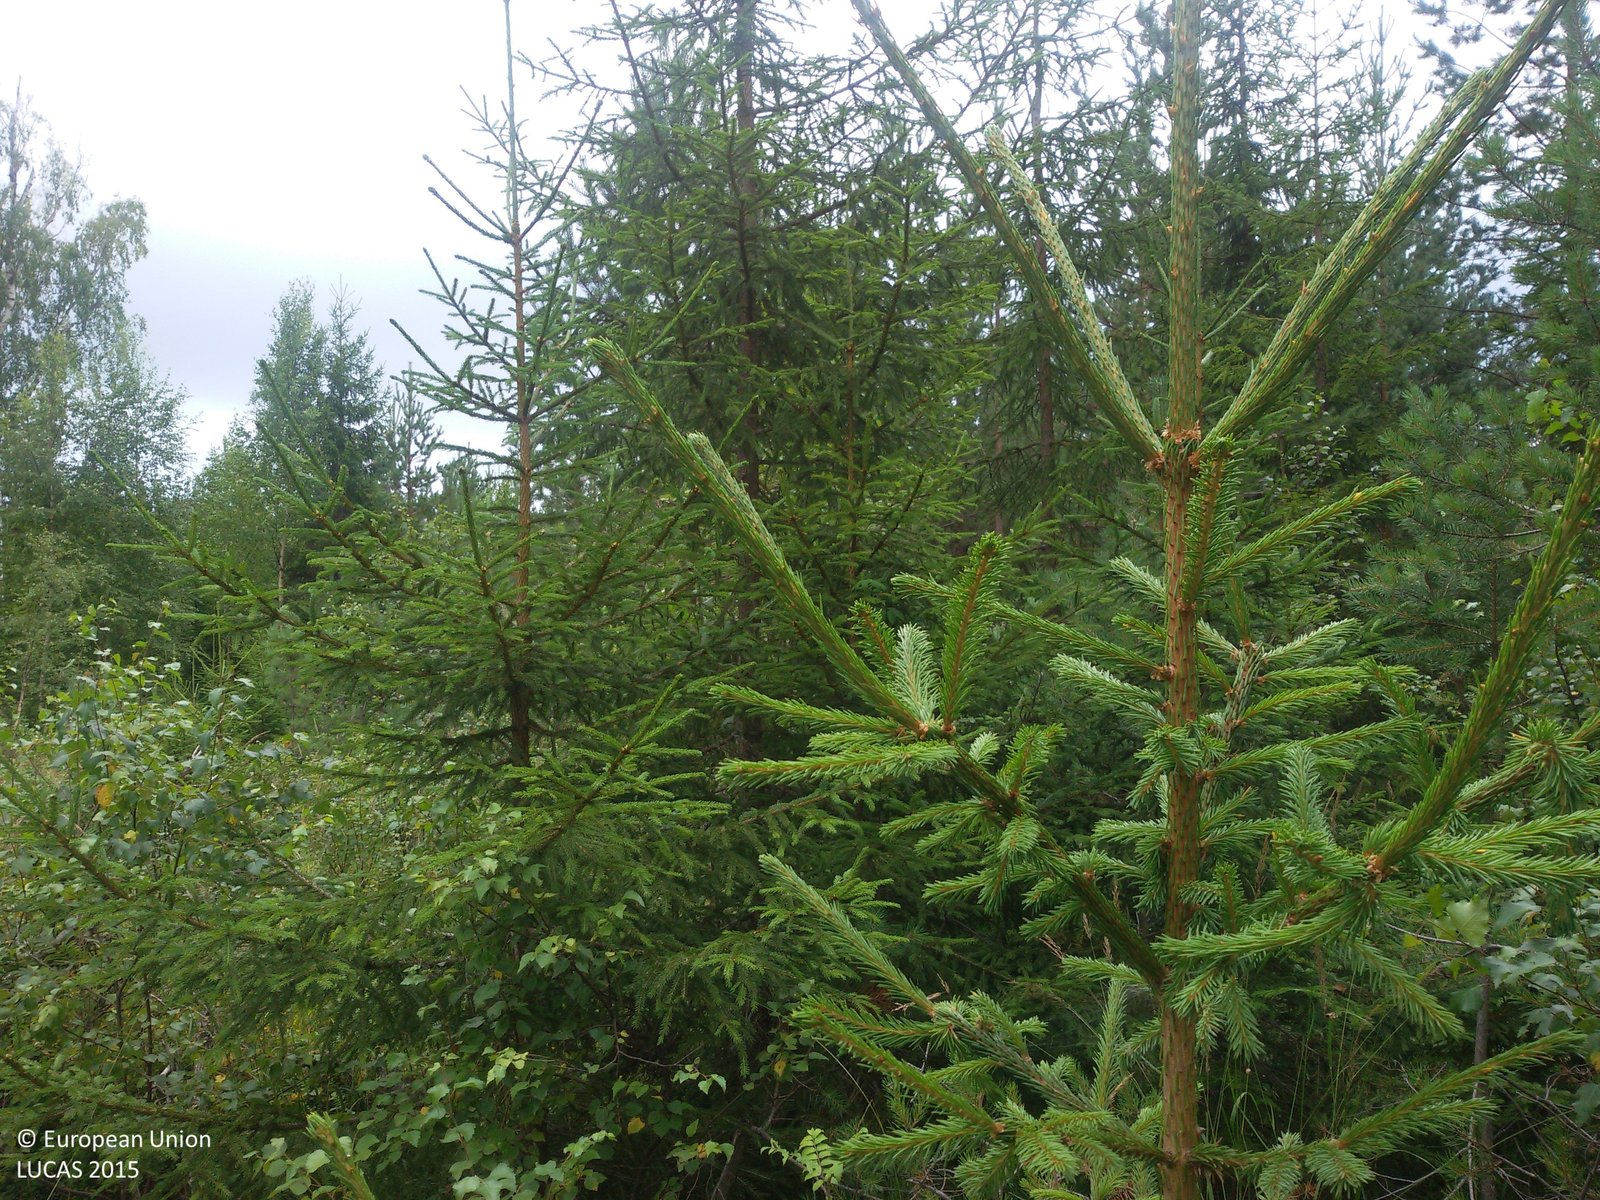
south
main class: Woodland
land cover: Other coniferous woodland
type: boreal forest
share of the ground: > 75 %
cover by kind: coniferous forest trees 65 %, herbaceous plants 20 %, broadleaved forest trees 15 %
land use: Forestry
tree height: < 5 m
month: August
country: SE
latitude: 60.8562
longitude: 16.6324
